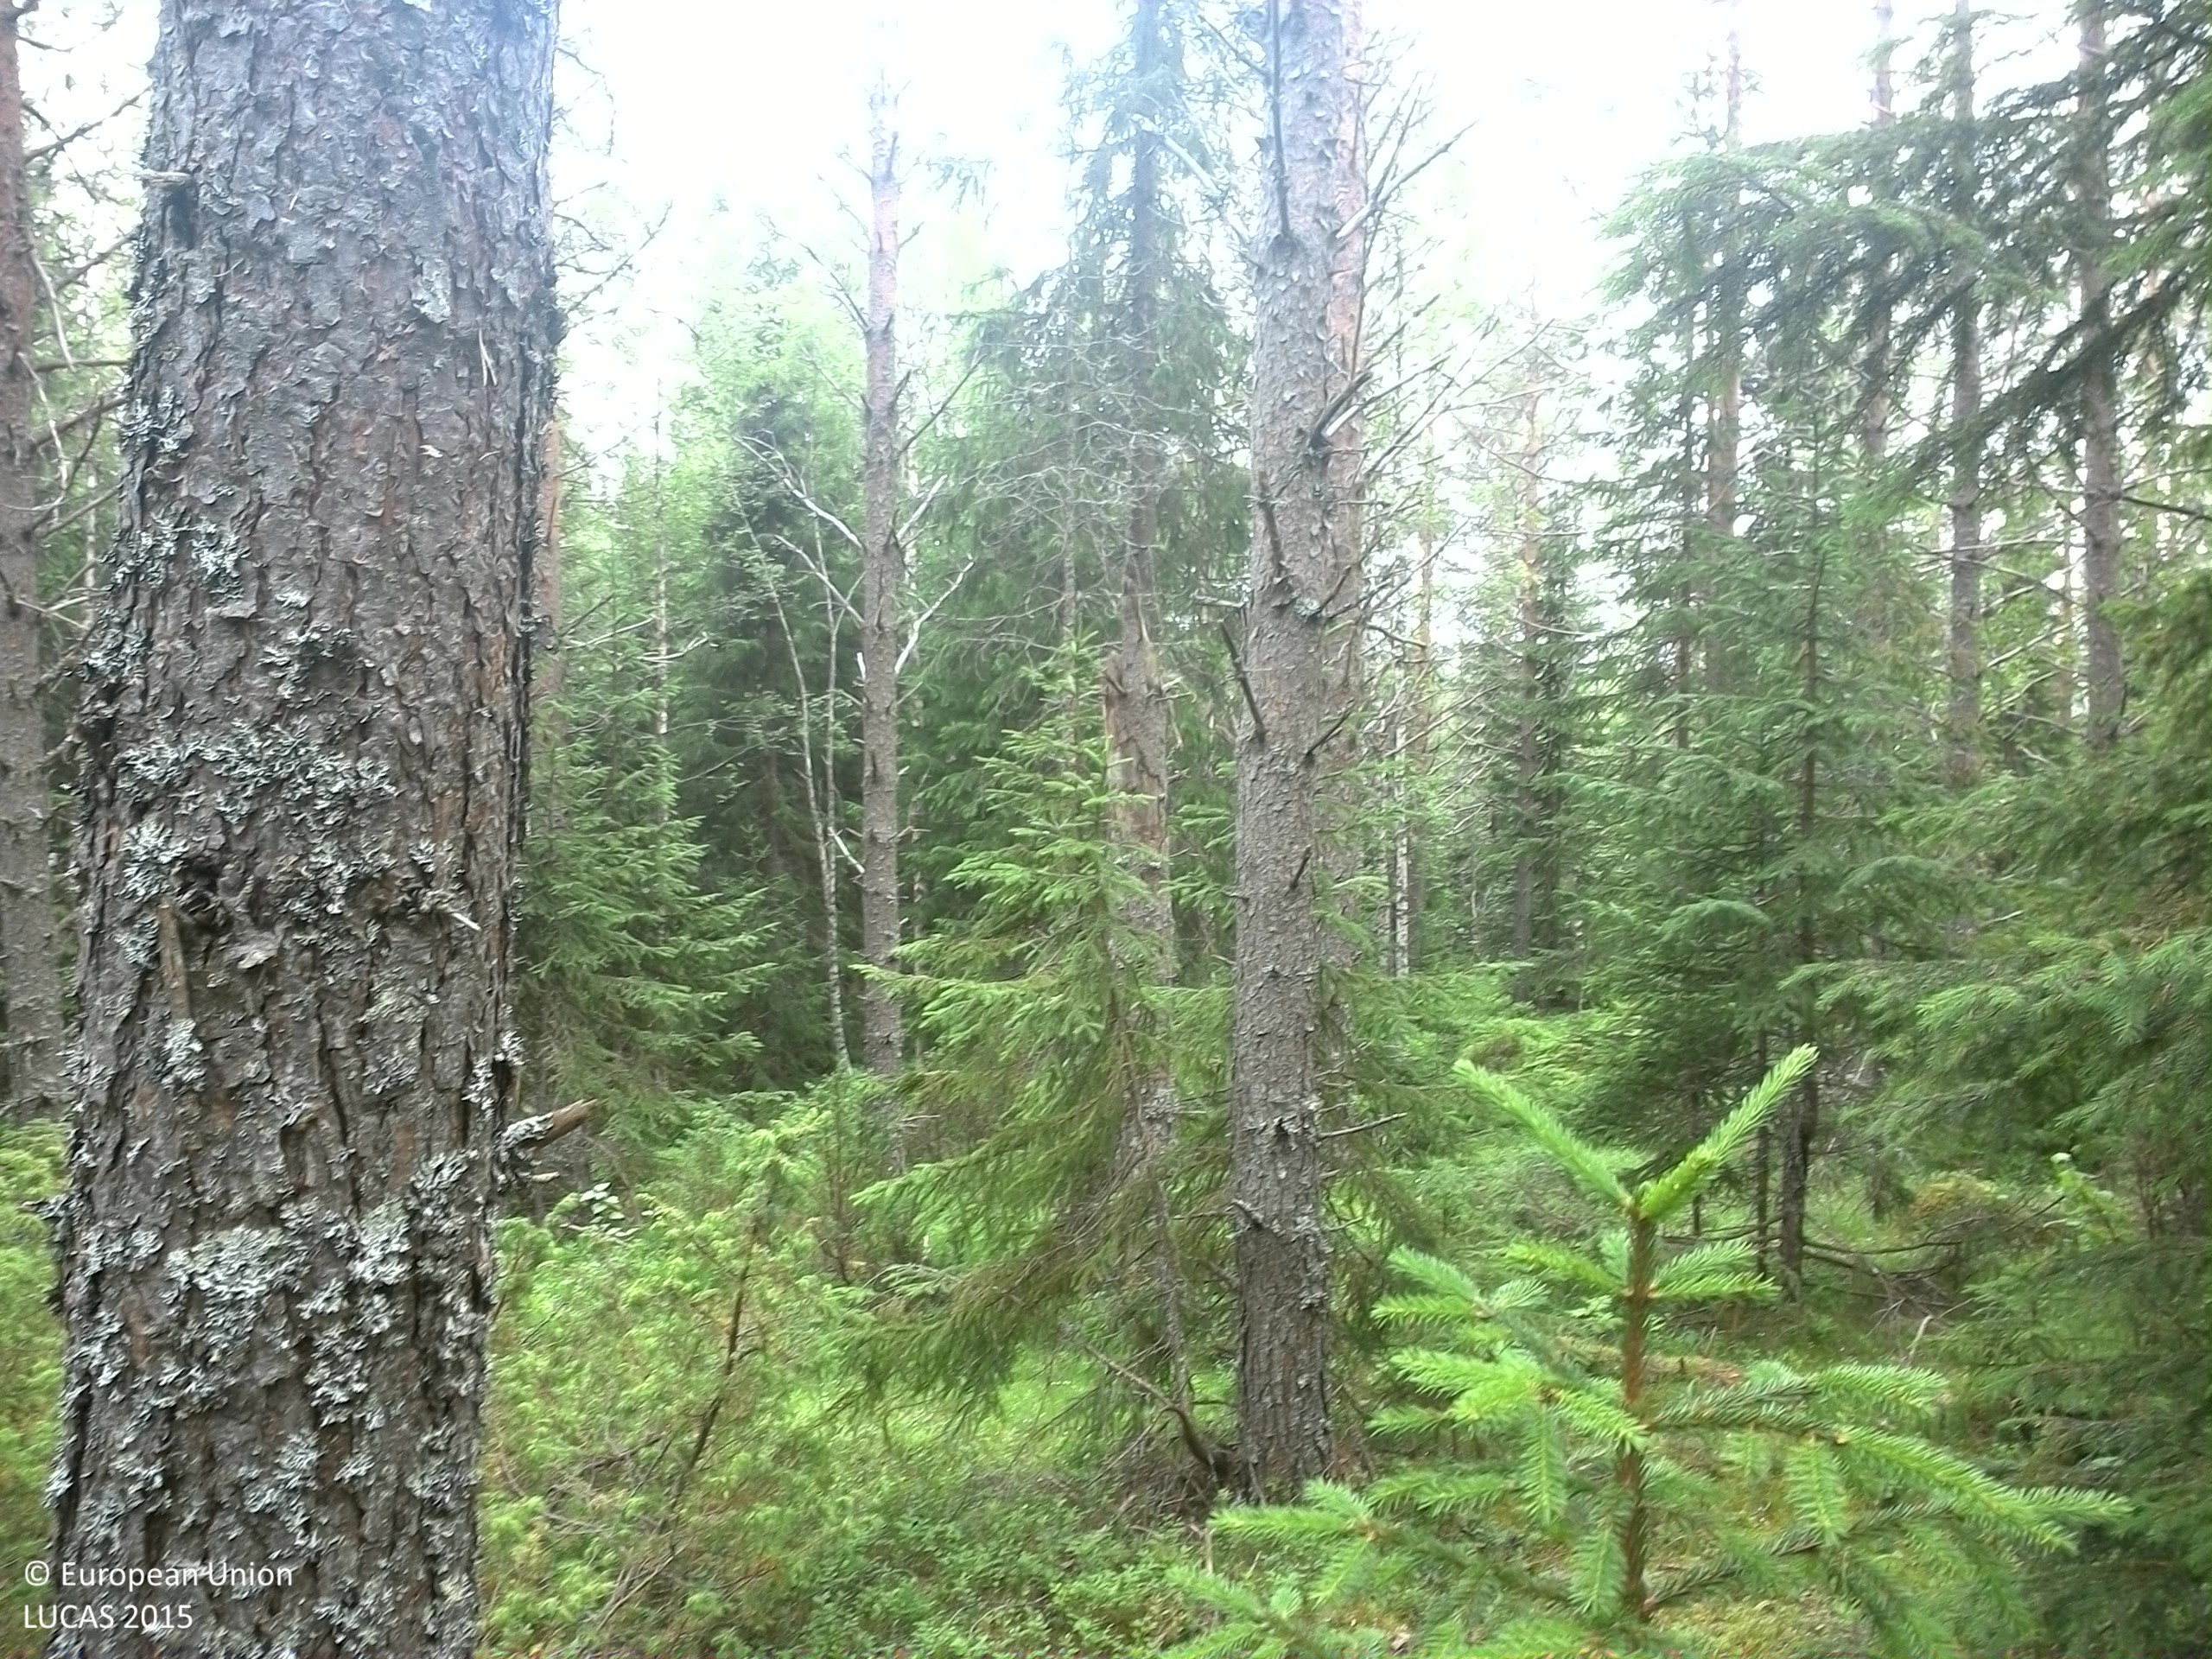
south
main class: Woodland
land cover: Pine dominated coniferous woodland
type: boreal forest
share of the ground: 50 - 75 %
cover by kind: coniferous forest trees 50 %, shrubs 30 %, lichens and mosses 15 %, herbaceous plants 5 %
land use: Forestry
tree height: > 5 m
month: July
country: SE
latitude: 62.7696
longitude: 17.1282
